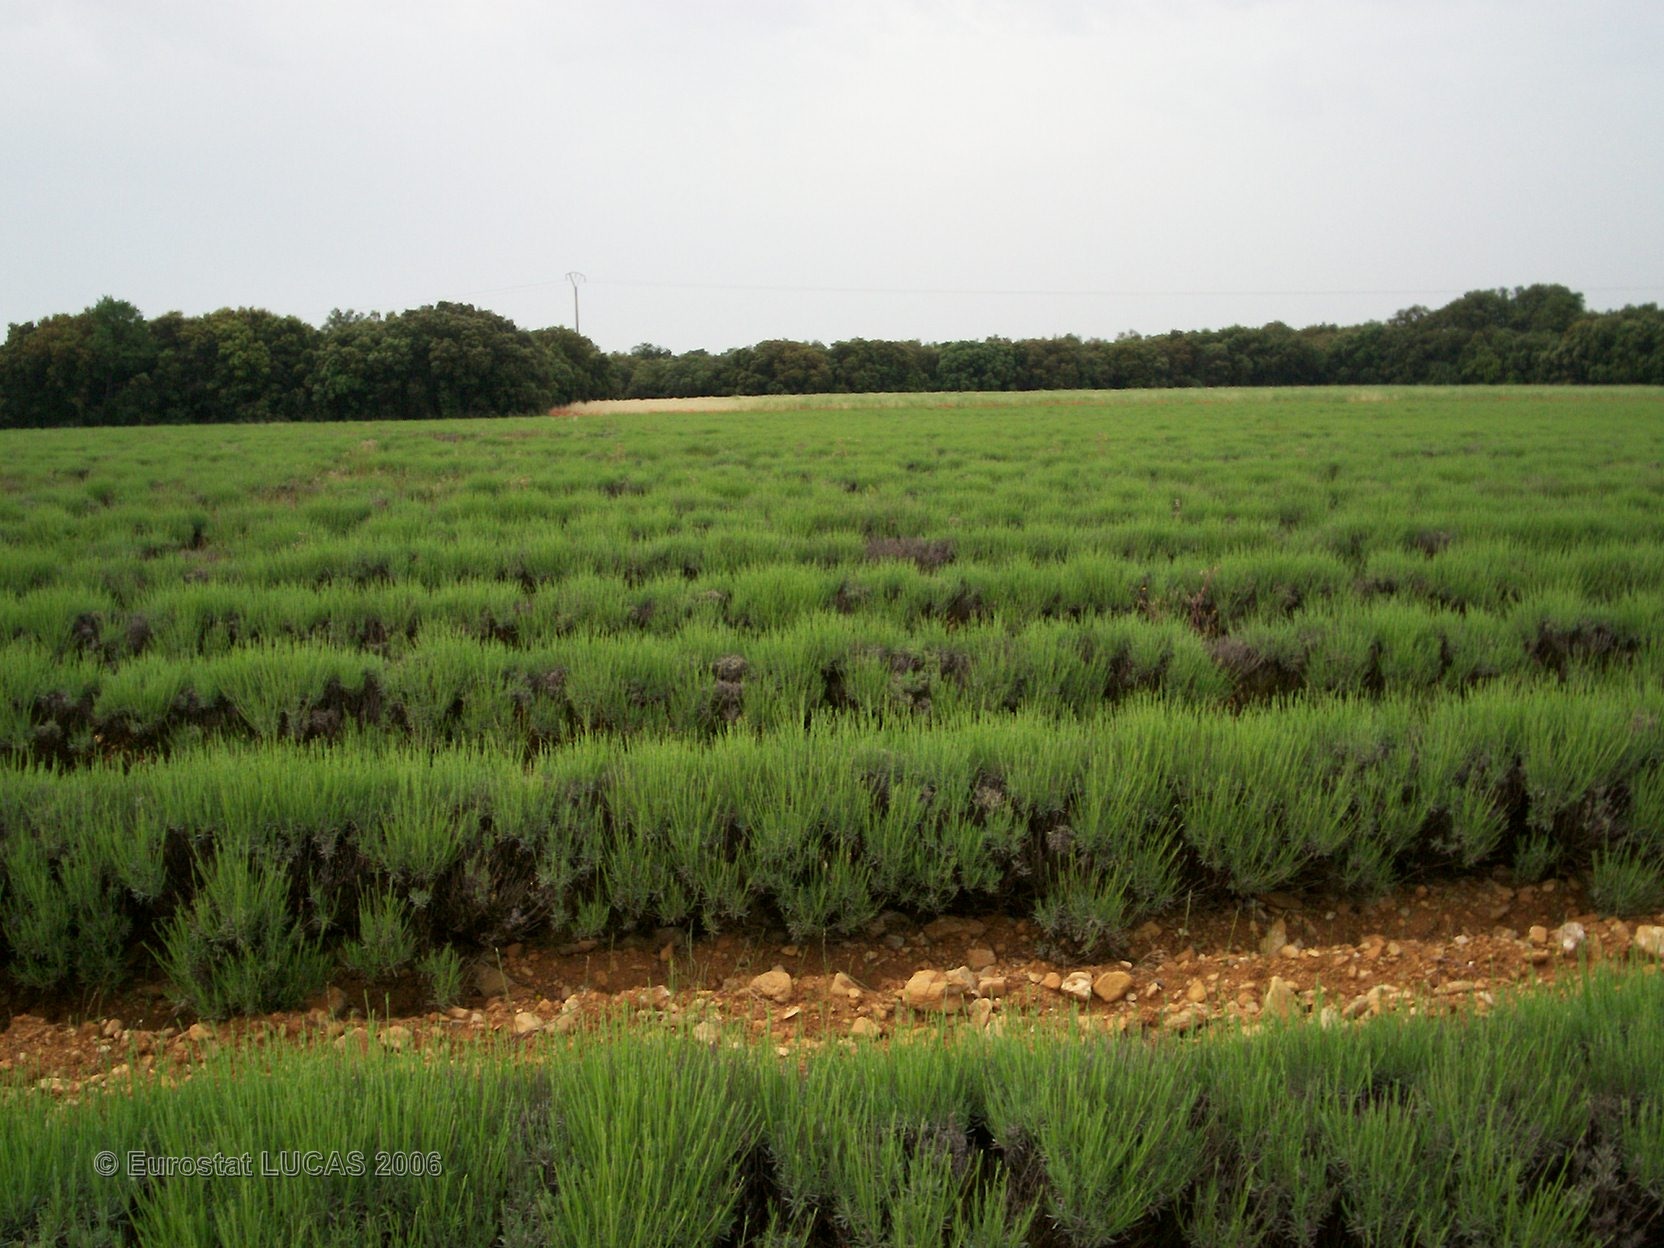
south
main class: Cropland
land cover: Permanent industrial crops
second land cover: Bare land
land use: Agriculture (excluding fallow land and kitchen gardens)
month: May
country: FR
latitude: 44.3709
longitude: 4.9248
